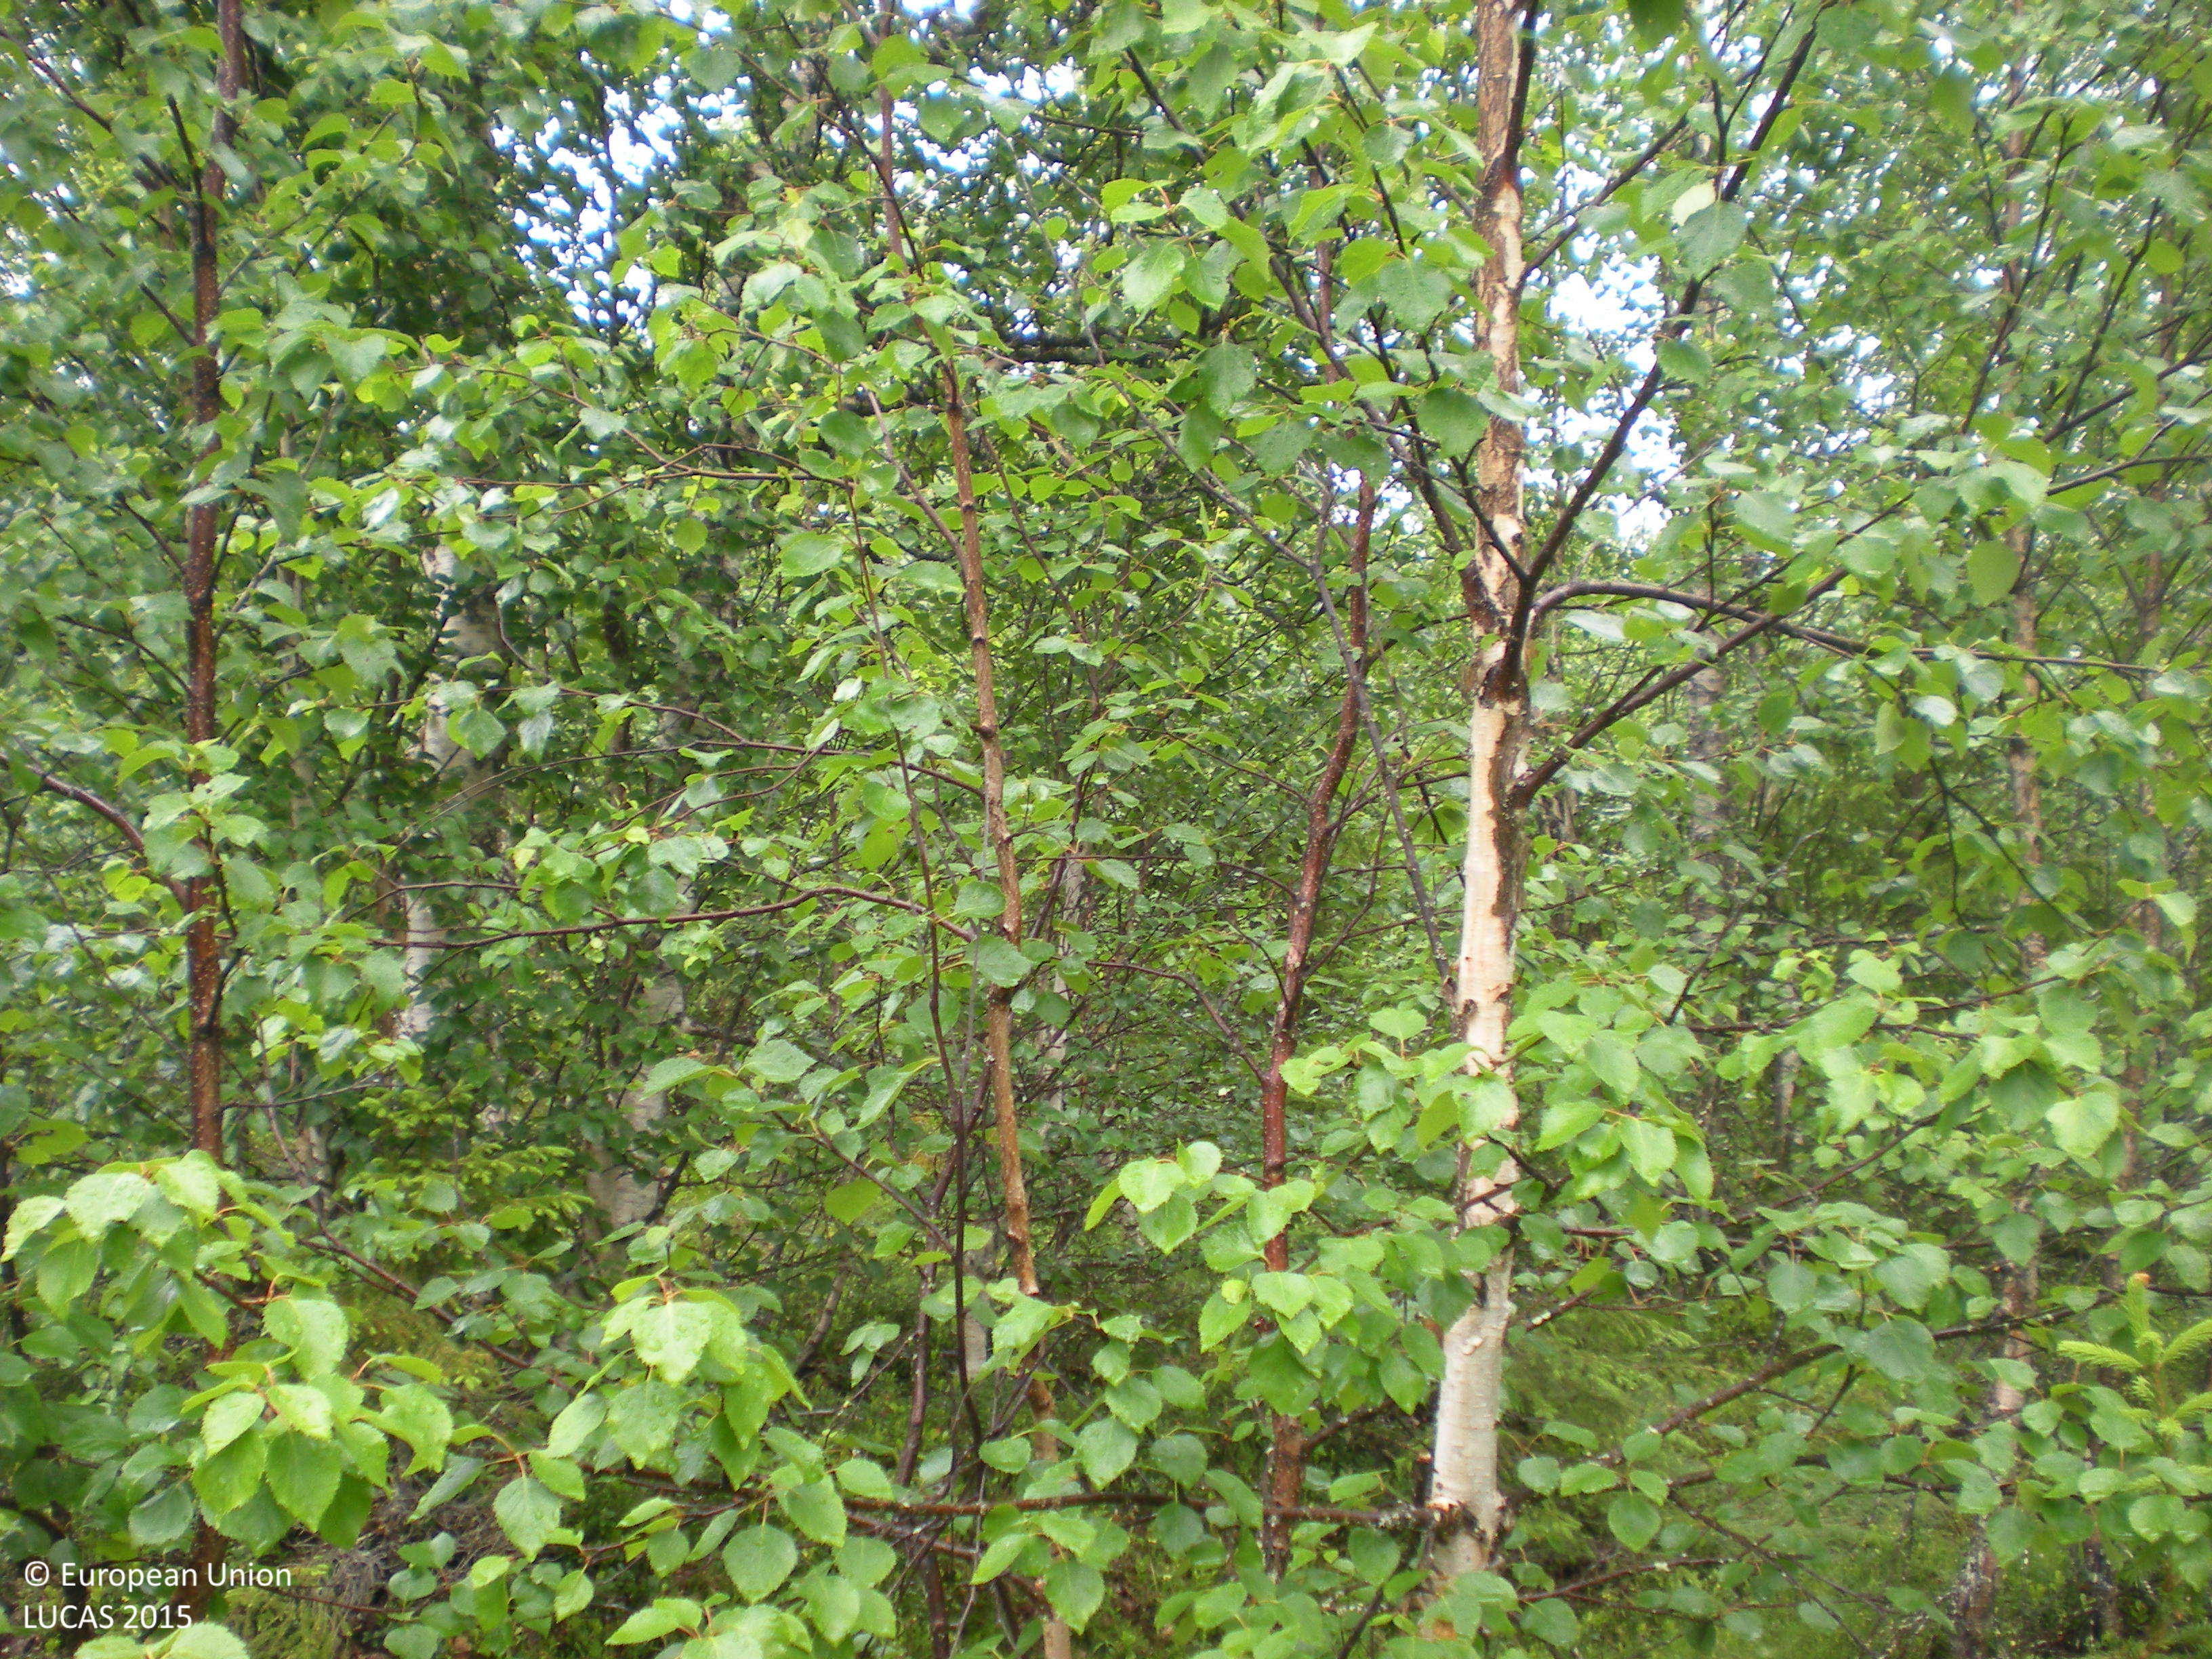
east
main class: Woodland
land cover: Spruce dominated mixed woodland
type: boreal forest
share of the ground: 50 - 75 %
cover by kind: broadleaved forest trees 55 %, coniferous forest trees 20 %, herbaceous plants 15 %, lichens and mosses 10 %
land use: Forestry
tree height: > 5 m
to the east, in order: Spruce dominated mixed woodland; Electric lines; Ditches and canals; Paved roads, cycling and walking lanes; Ditches and canals; Spruce dominated mixed woodland; Rivers and streams; Grassland with sparse tree/shrub cover
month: July
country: SE
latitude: 65.8700
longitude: 17.1697
